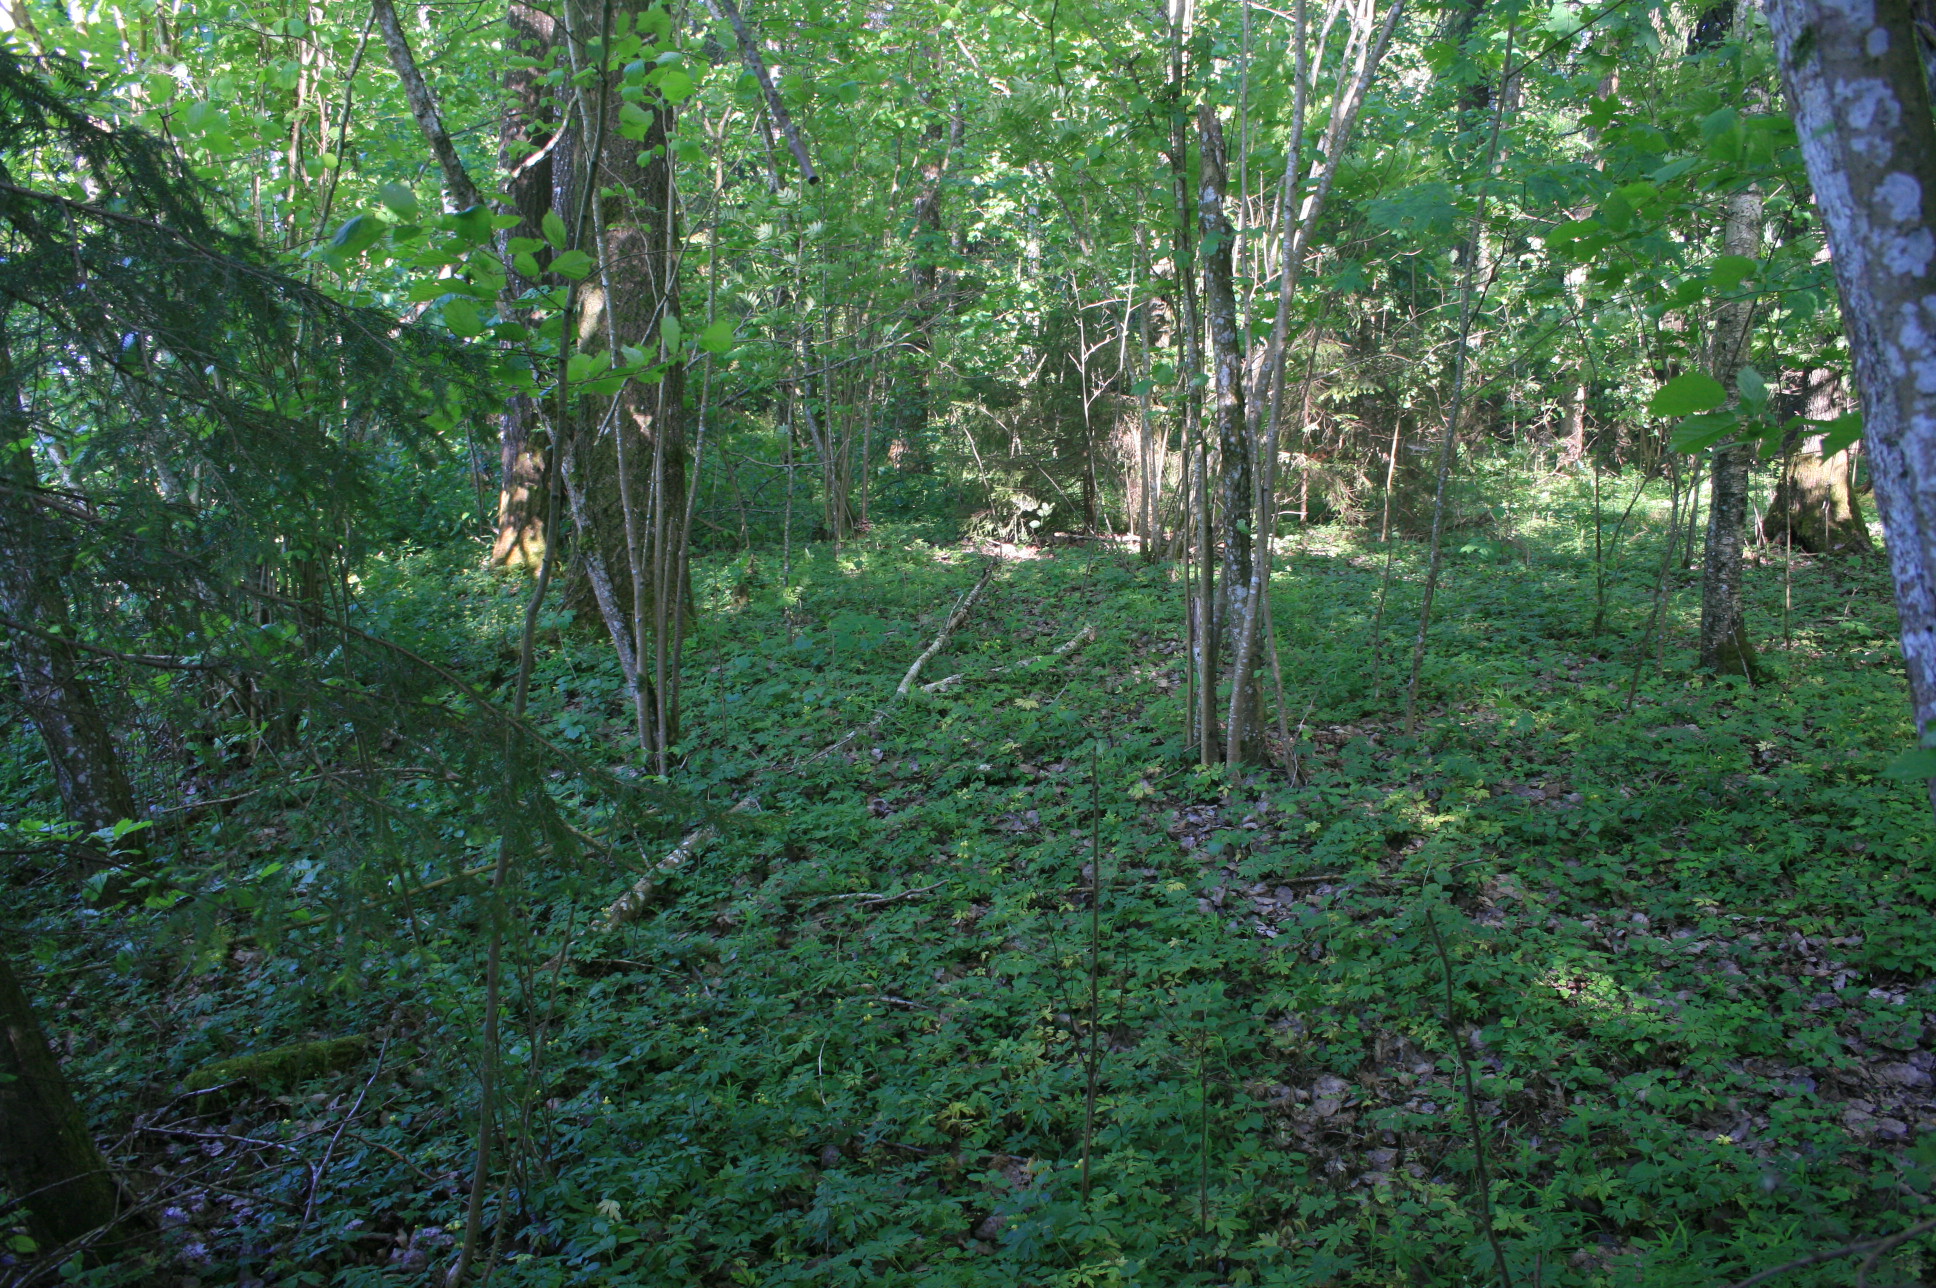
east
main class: Woodland
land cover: Broadleaved woodland
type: non-riverine alder, birch or aspen forest
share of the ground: > 75 %
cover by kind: broadleaved forest trees 95 %, herbaceous plants 5 %
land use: Forestry
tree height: > 5 m
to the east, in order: Broadleaved woodland; Electric lines; Broadleaved woodland; Grassland without tree/shrub cover; Broadleaved woodland
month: June
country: LT
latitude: 56.0192
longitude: 22.0357
